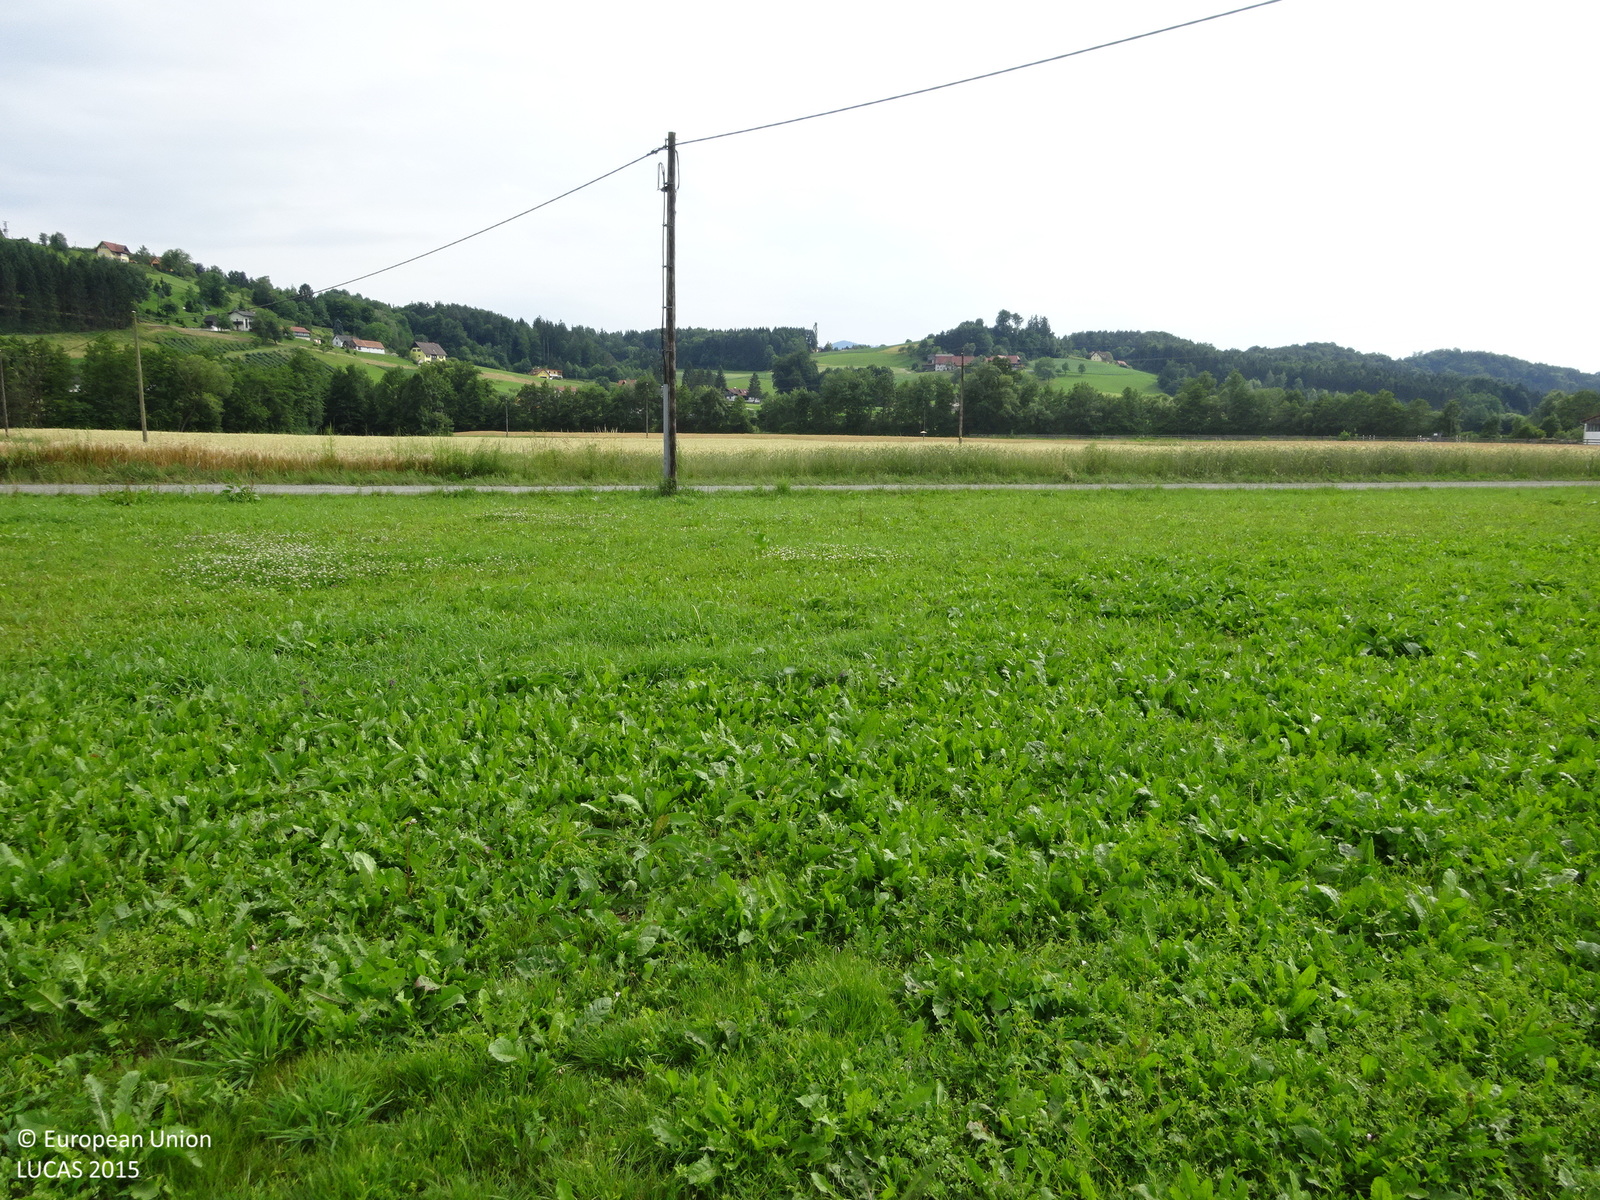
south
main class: Cropland
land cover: Other fresh vegetables
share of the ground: 25 - 50 %
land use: Kitchen garden
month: June
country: AT
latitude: 46.7253
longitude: 15.2980
